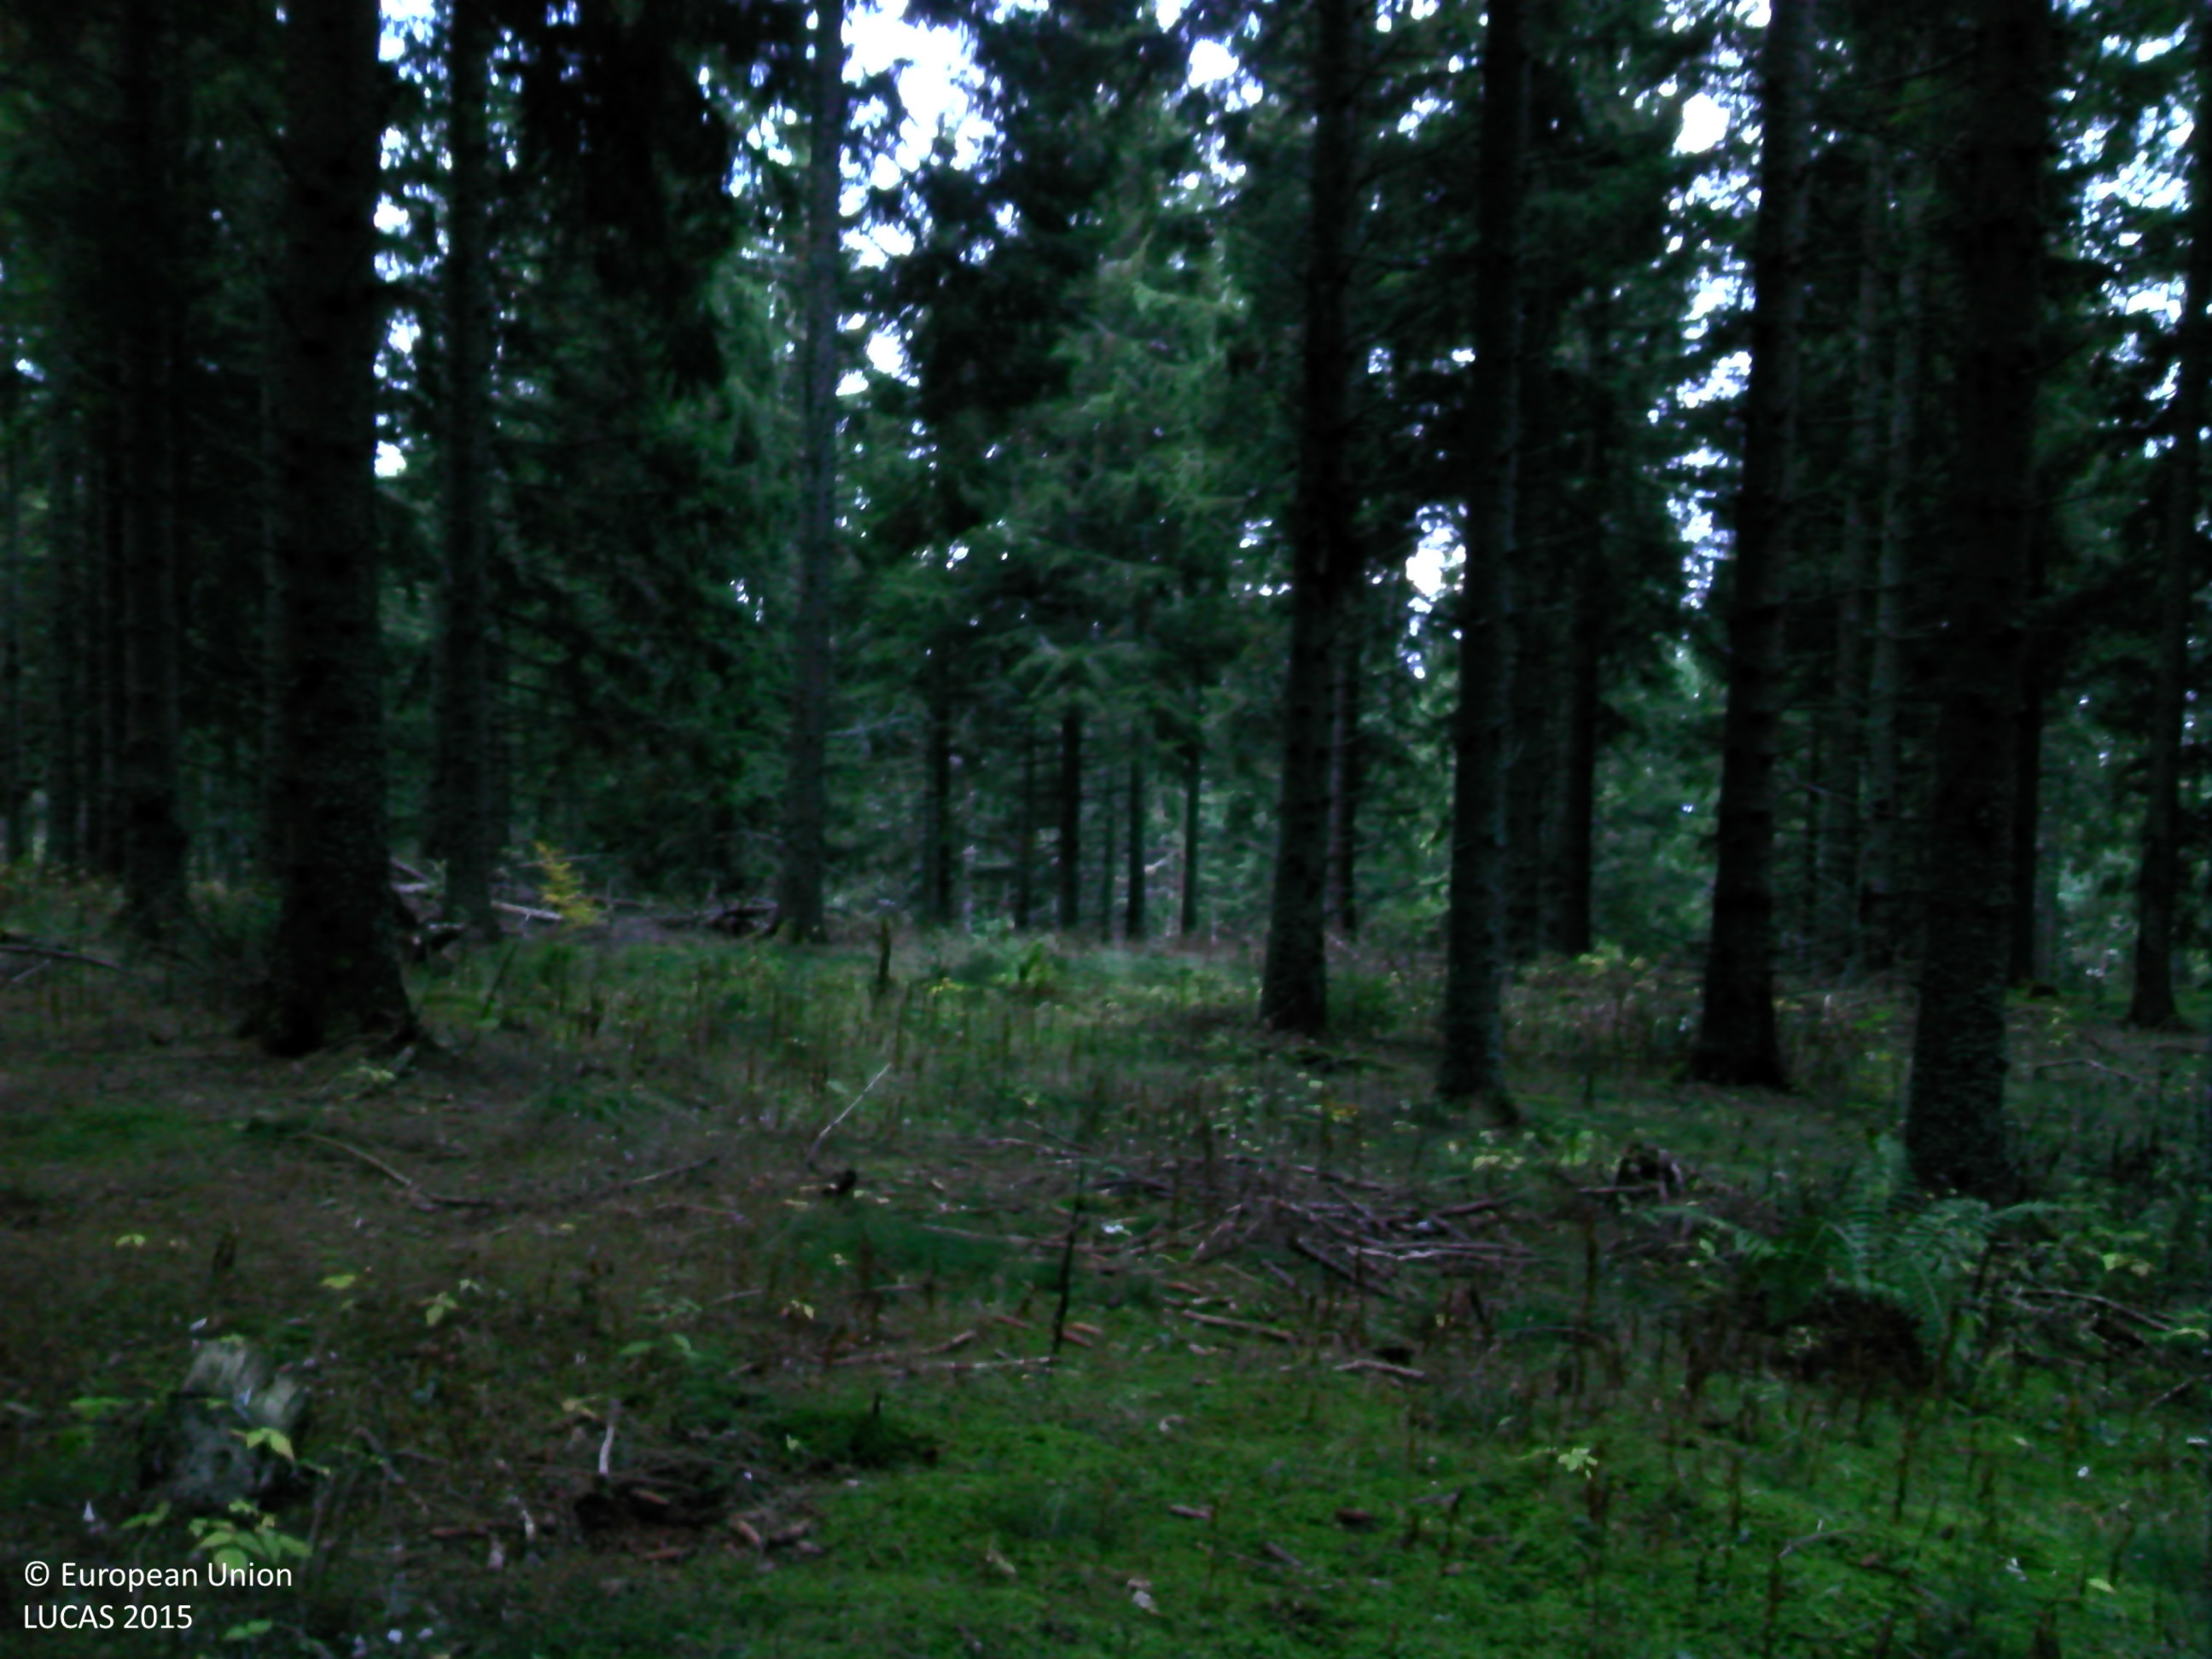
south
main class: Woodland
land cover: Spruce dominated coniferous woodland
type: exotic forest
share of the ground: > 75 %
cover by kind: coniferous forest trees 80 %, shrubs 10 %, herbaceous plants 5 %, lichens and mosses 5 %
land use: Forestry
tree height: > 5 m
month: October
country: FR
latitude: 44.7679
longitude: 3.9024
